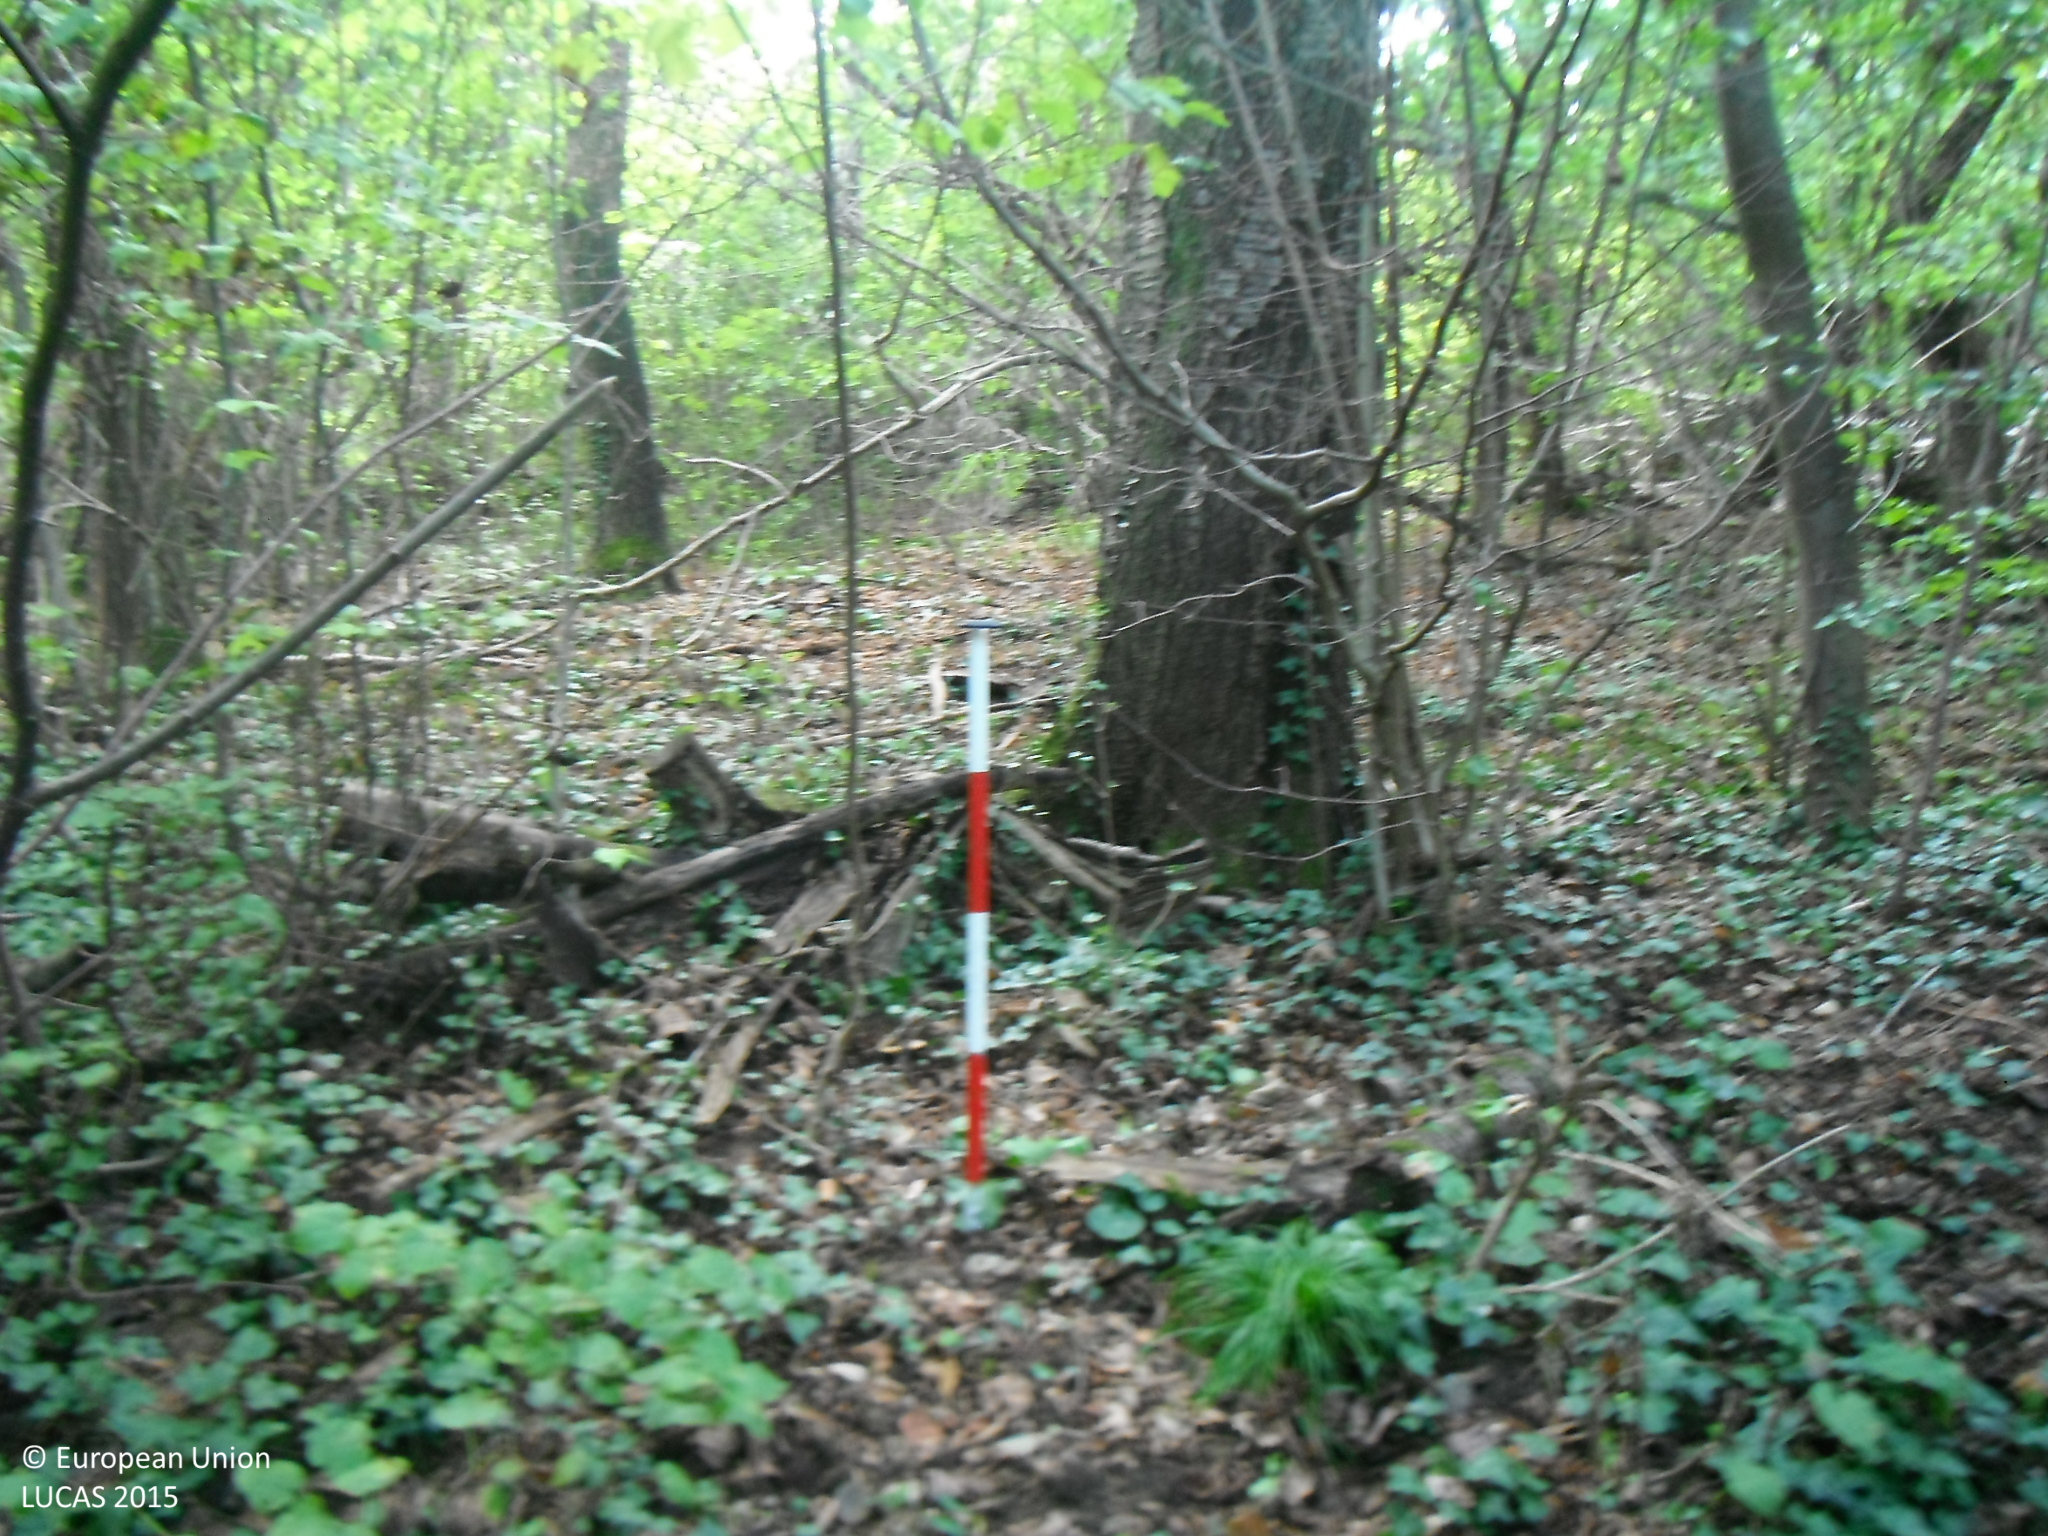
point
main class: Woodland
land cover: Broadleaved woodland
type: mesophytic deciduous forest
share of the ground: > 75 %
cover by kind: broadleaved forest trees 100 %
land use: Forestry
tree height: > 5 m
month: September
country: SK
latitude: 48.9230
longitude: 18.0532
